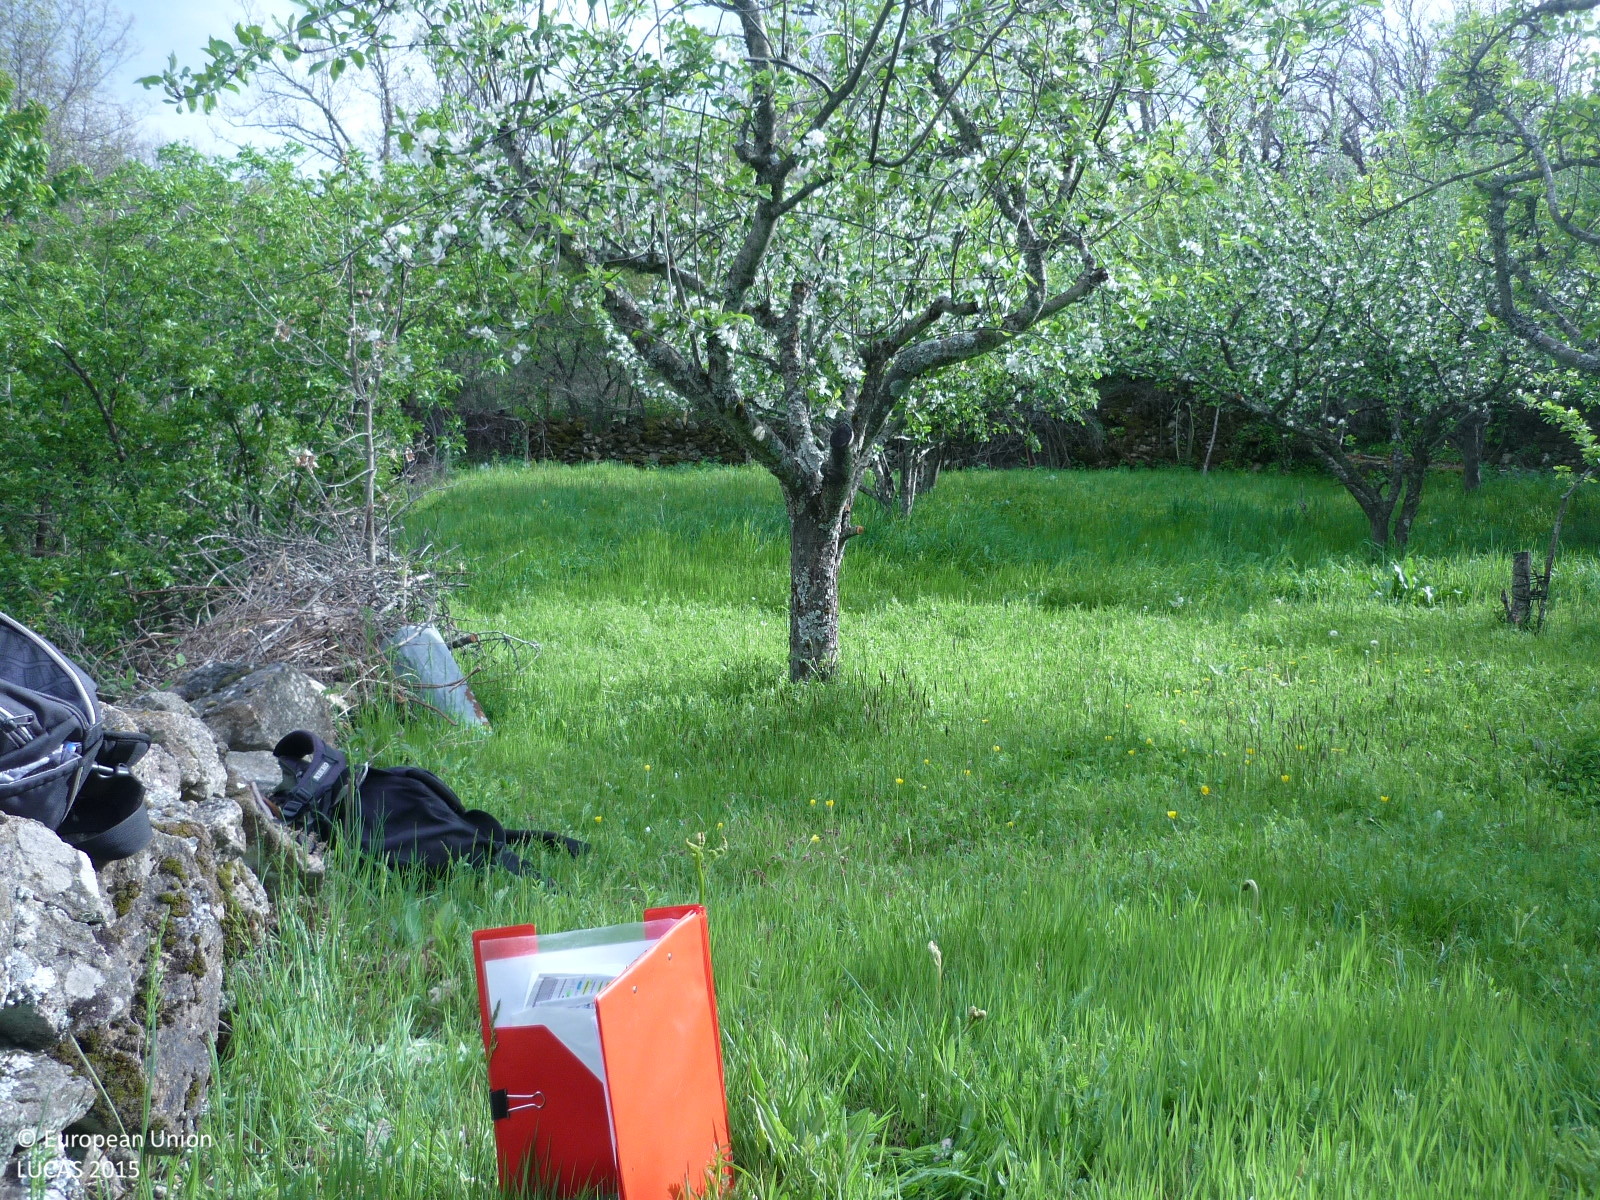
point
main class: Cropland
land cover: Apple fruit
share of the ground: 25 - 50 %
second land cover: Grassland without tree/shrub cover
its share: > 75 %
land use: Agriculture (excluding fallow land and kitchen gardens)
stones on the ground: < 10 %
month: May
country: ES
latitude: 41.0878
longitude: -3.6277
